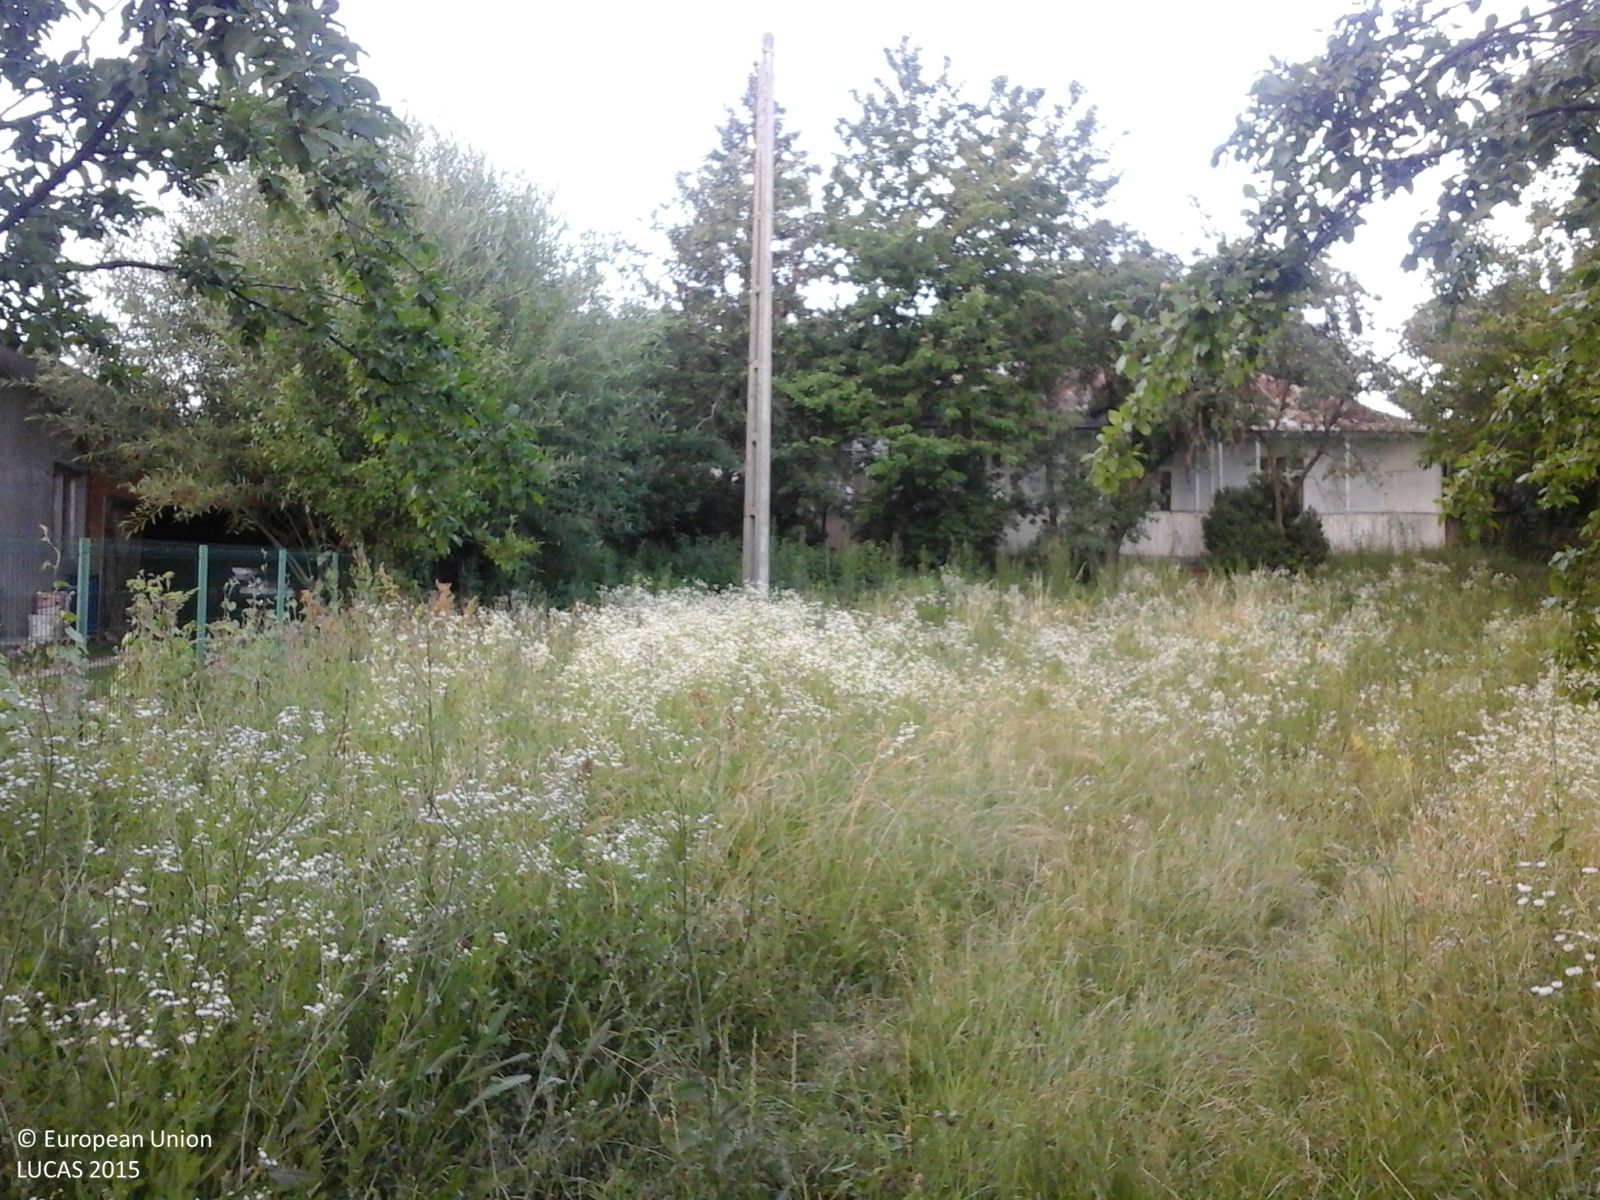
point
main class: Grassland
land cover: Grassland without tree/shrub cover
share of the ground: > 75 %
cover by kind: herbaceous plants 100 %
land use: Agriculture (excluding fallow land and kitchen gardens)
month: June
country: RO
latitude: 48.2015
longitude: 26.6054
